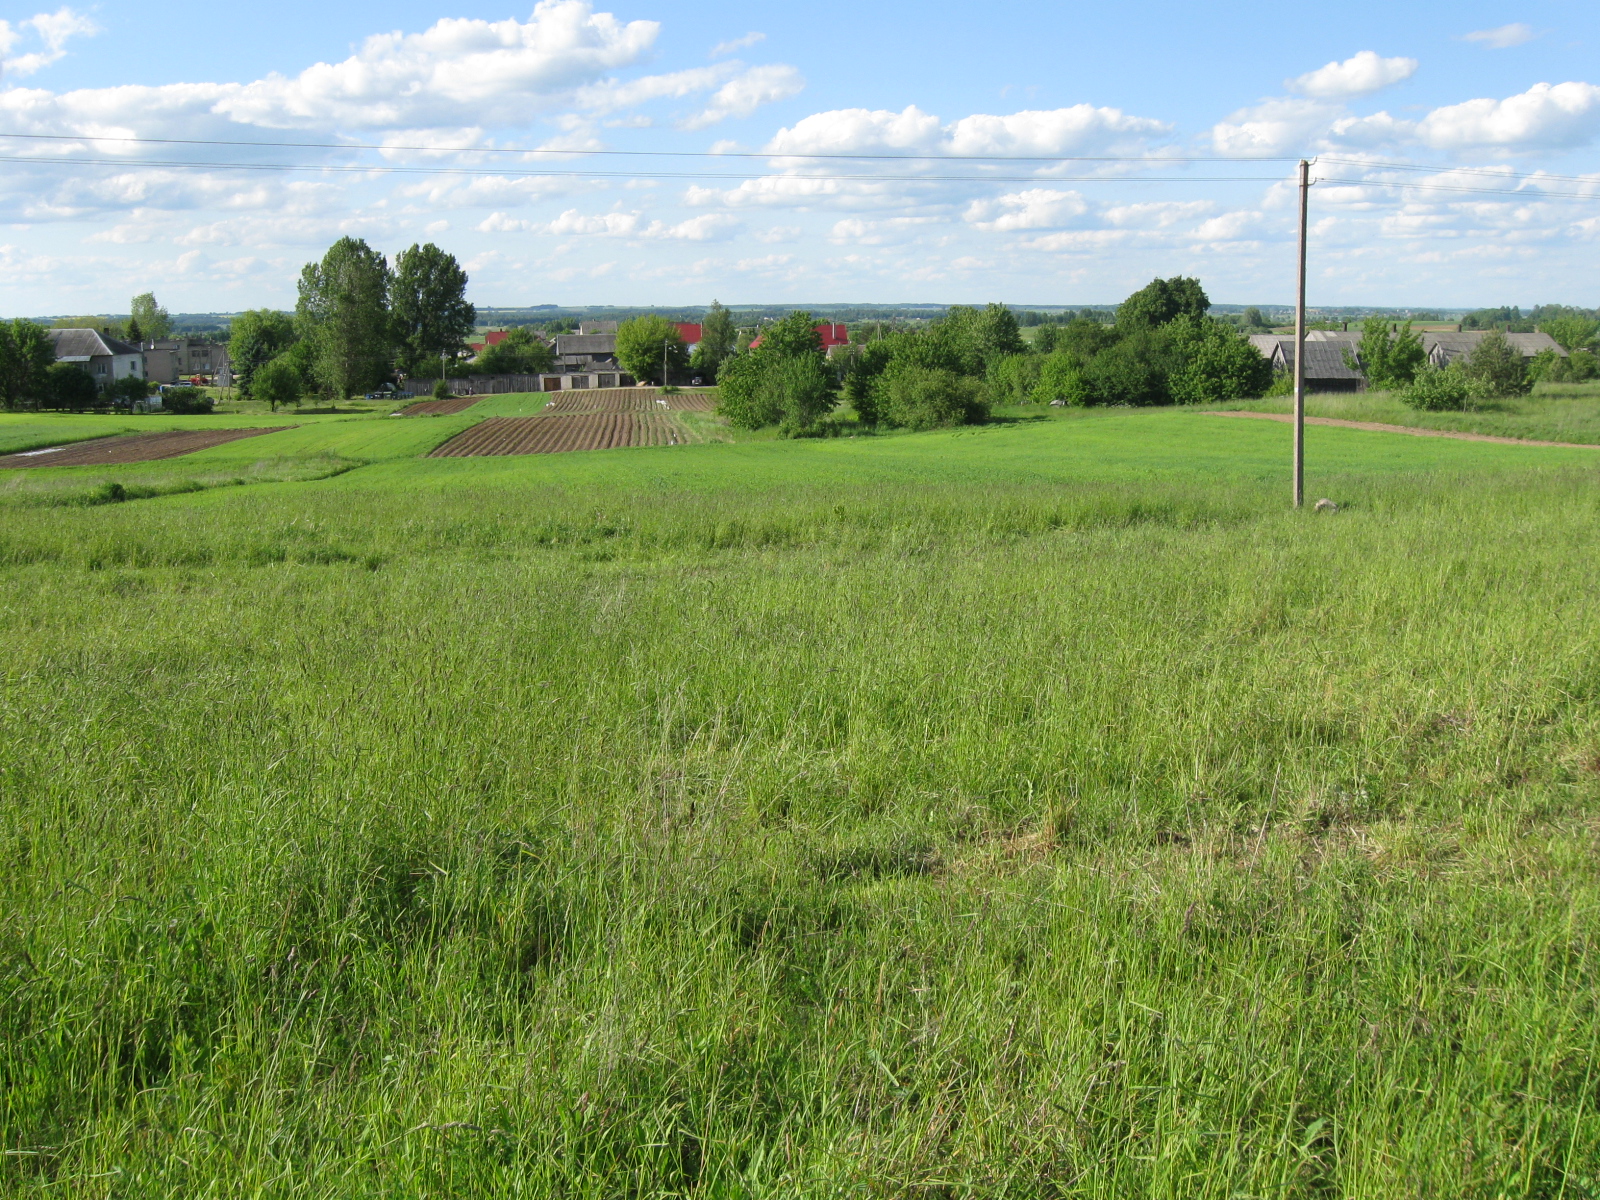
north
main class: Grassland
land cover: Grassland without tree/shrub cover
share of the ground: > 75 %
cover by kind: herbaceous plants 95 %, unconsolidated bare surface 5 %
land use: Agriculture (excluding fallow land and kitchen gardens)
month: May
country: LT
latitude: 54.2943
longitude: 23.4013
